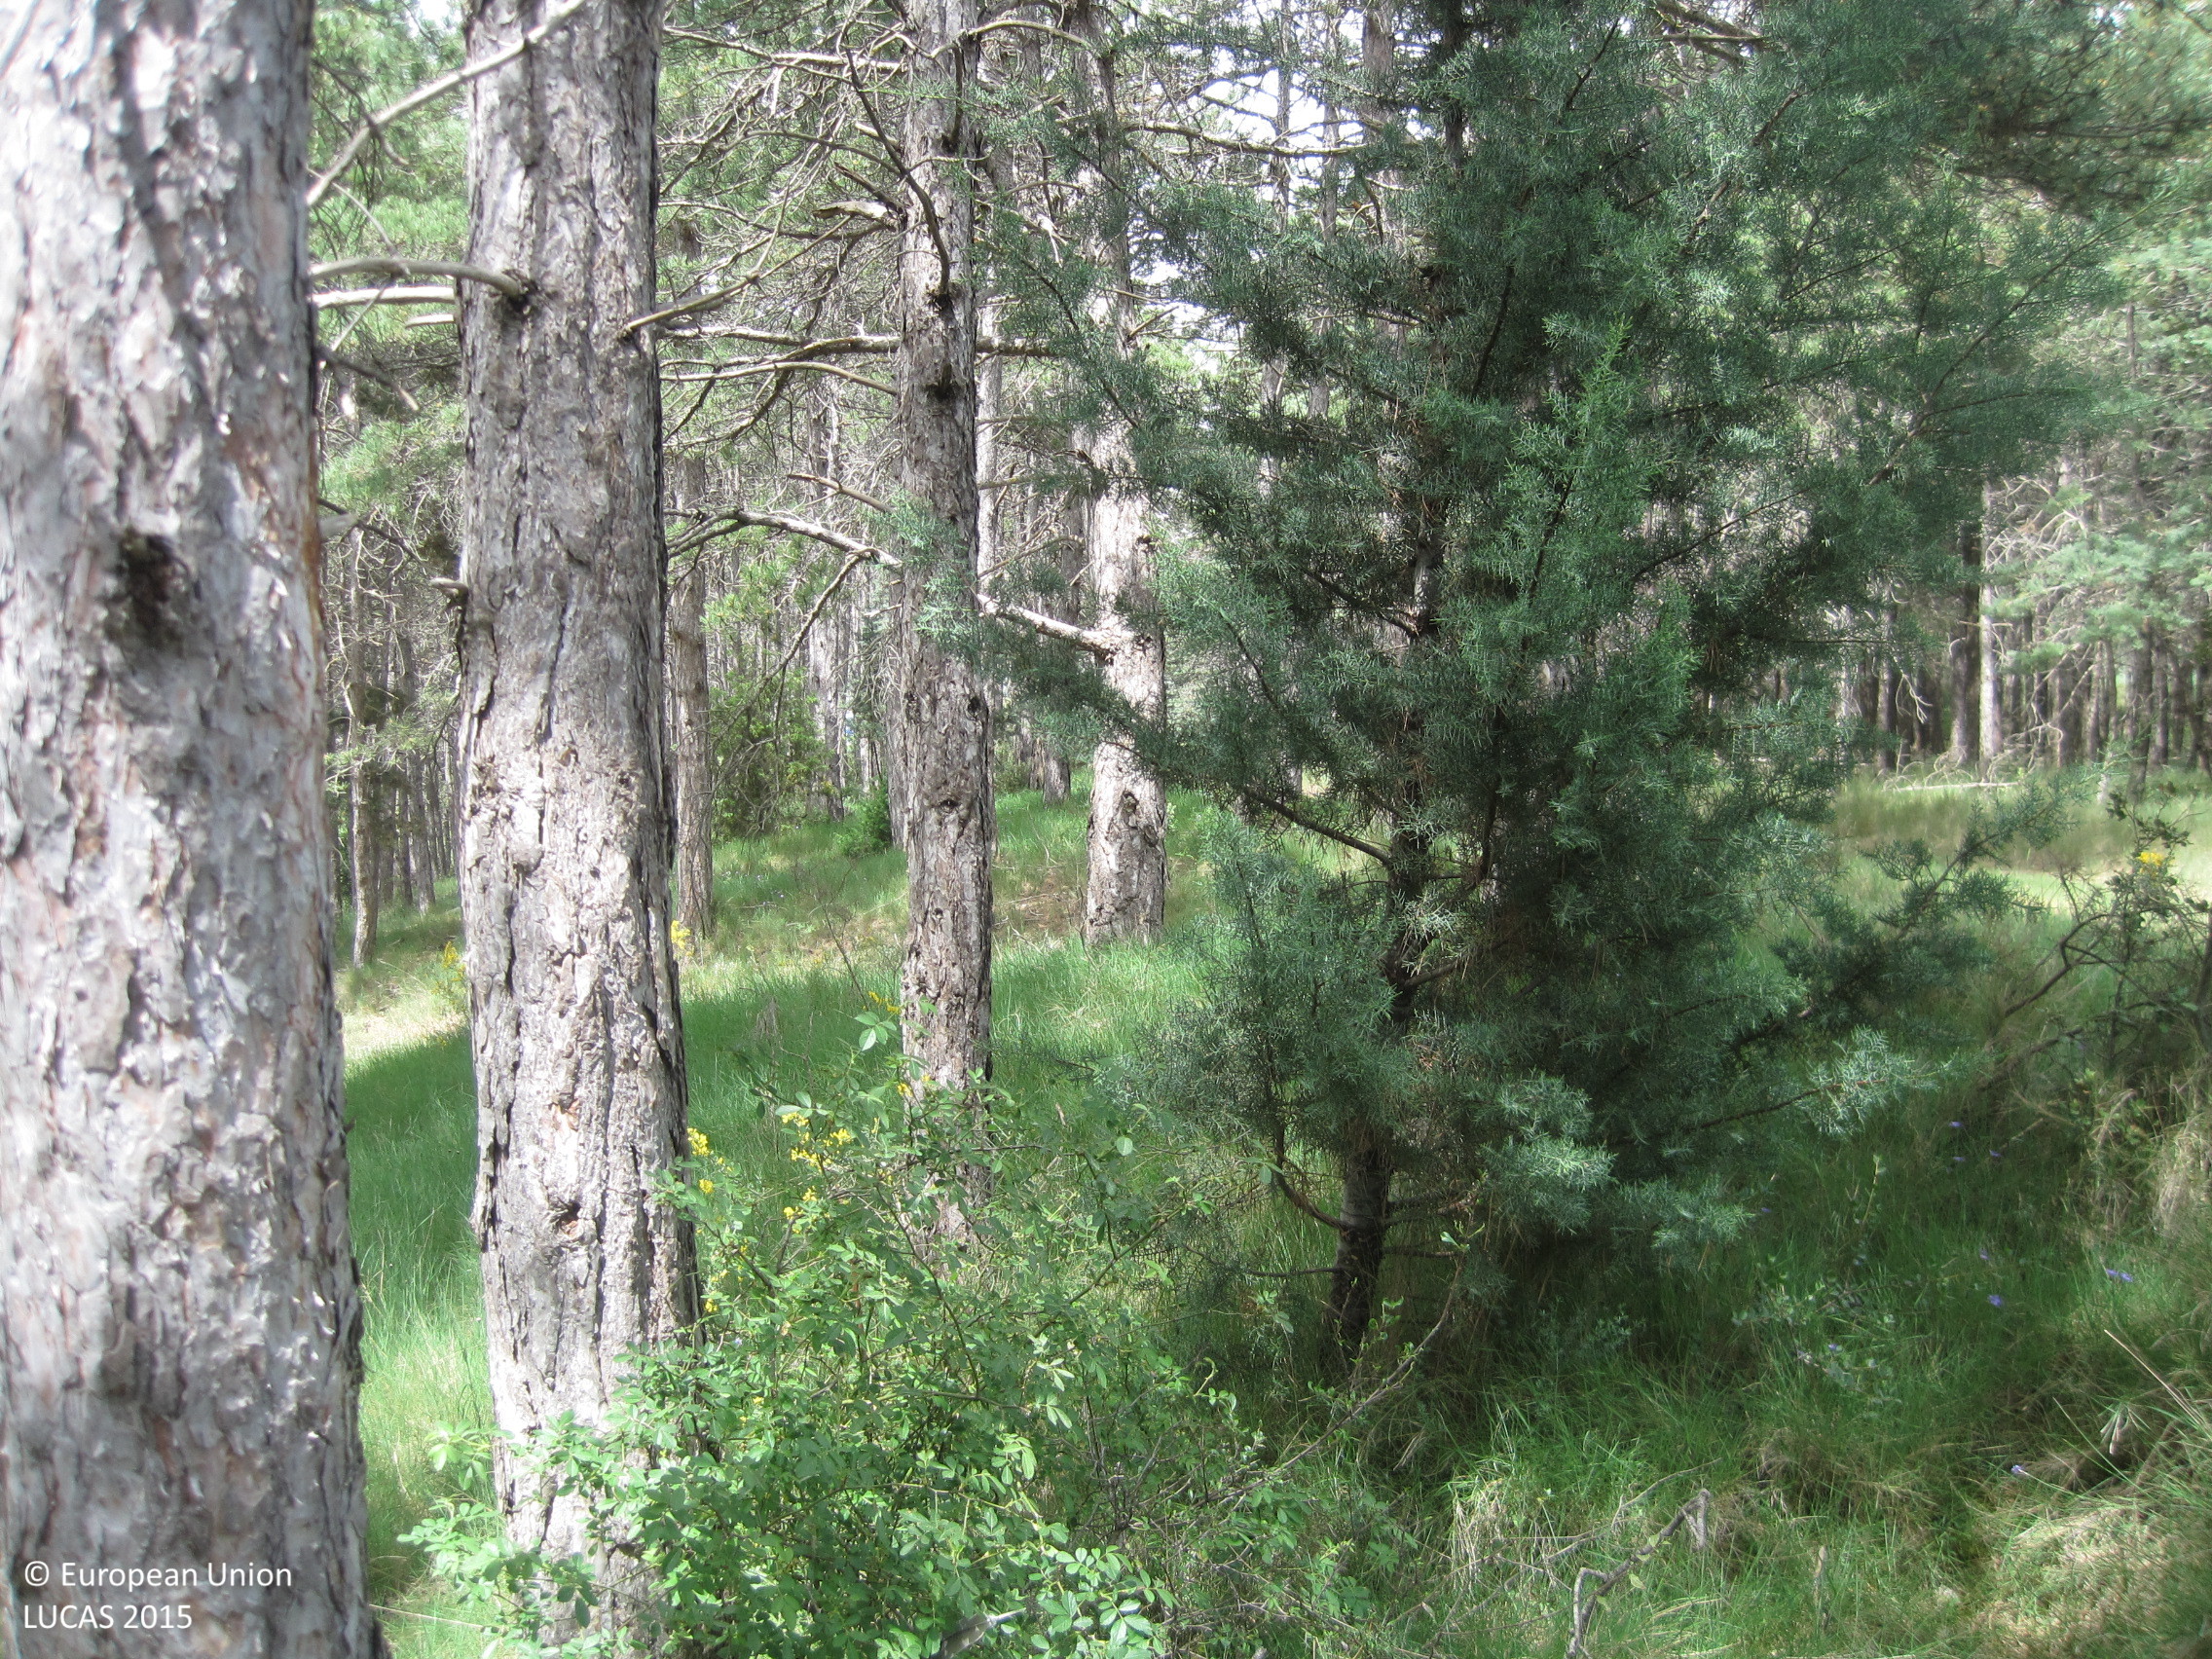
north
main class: Woodland
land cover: Pine dominated coniferous woodland
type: coniferous forest of the mediterranean region
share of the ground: > 75 %
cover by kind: coniferous forest trees 100 %
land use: Forestry
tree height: > 5 m
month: May
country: ES
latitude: 42.6372
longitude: -1.6351
